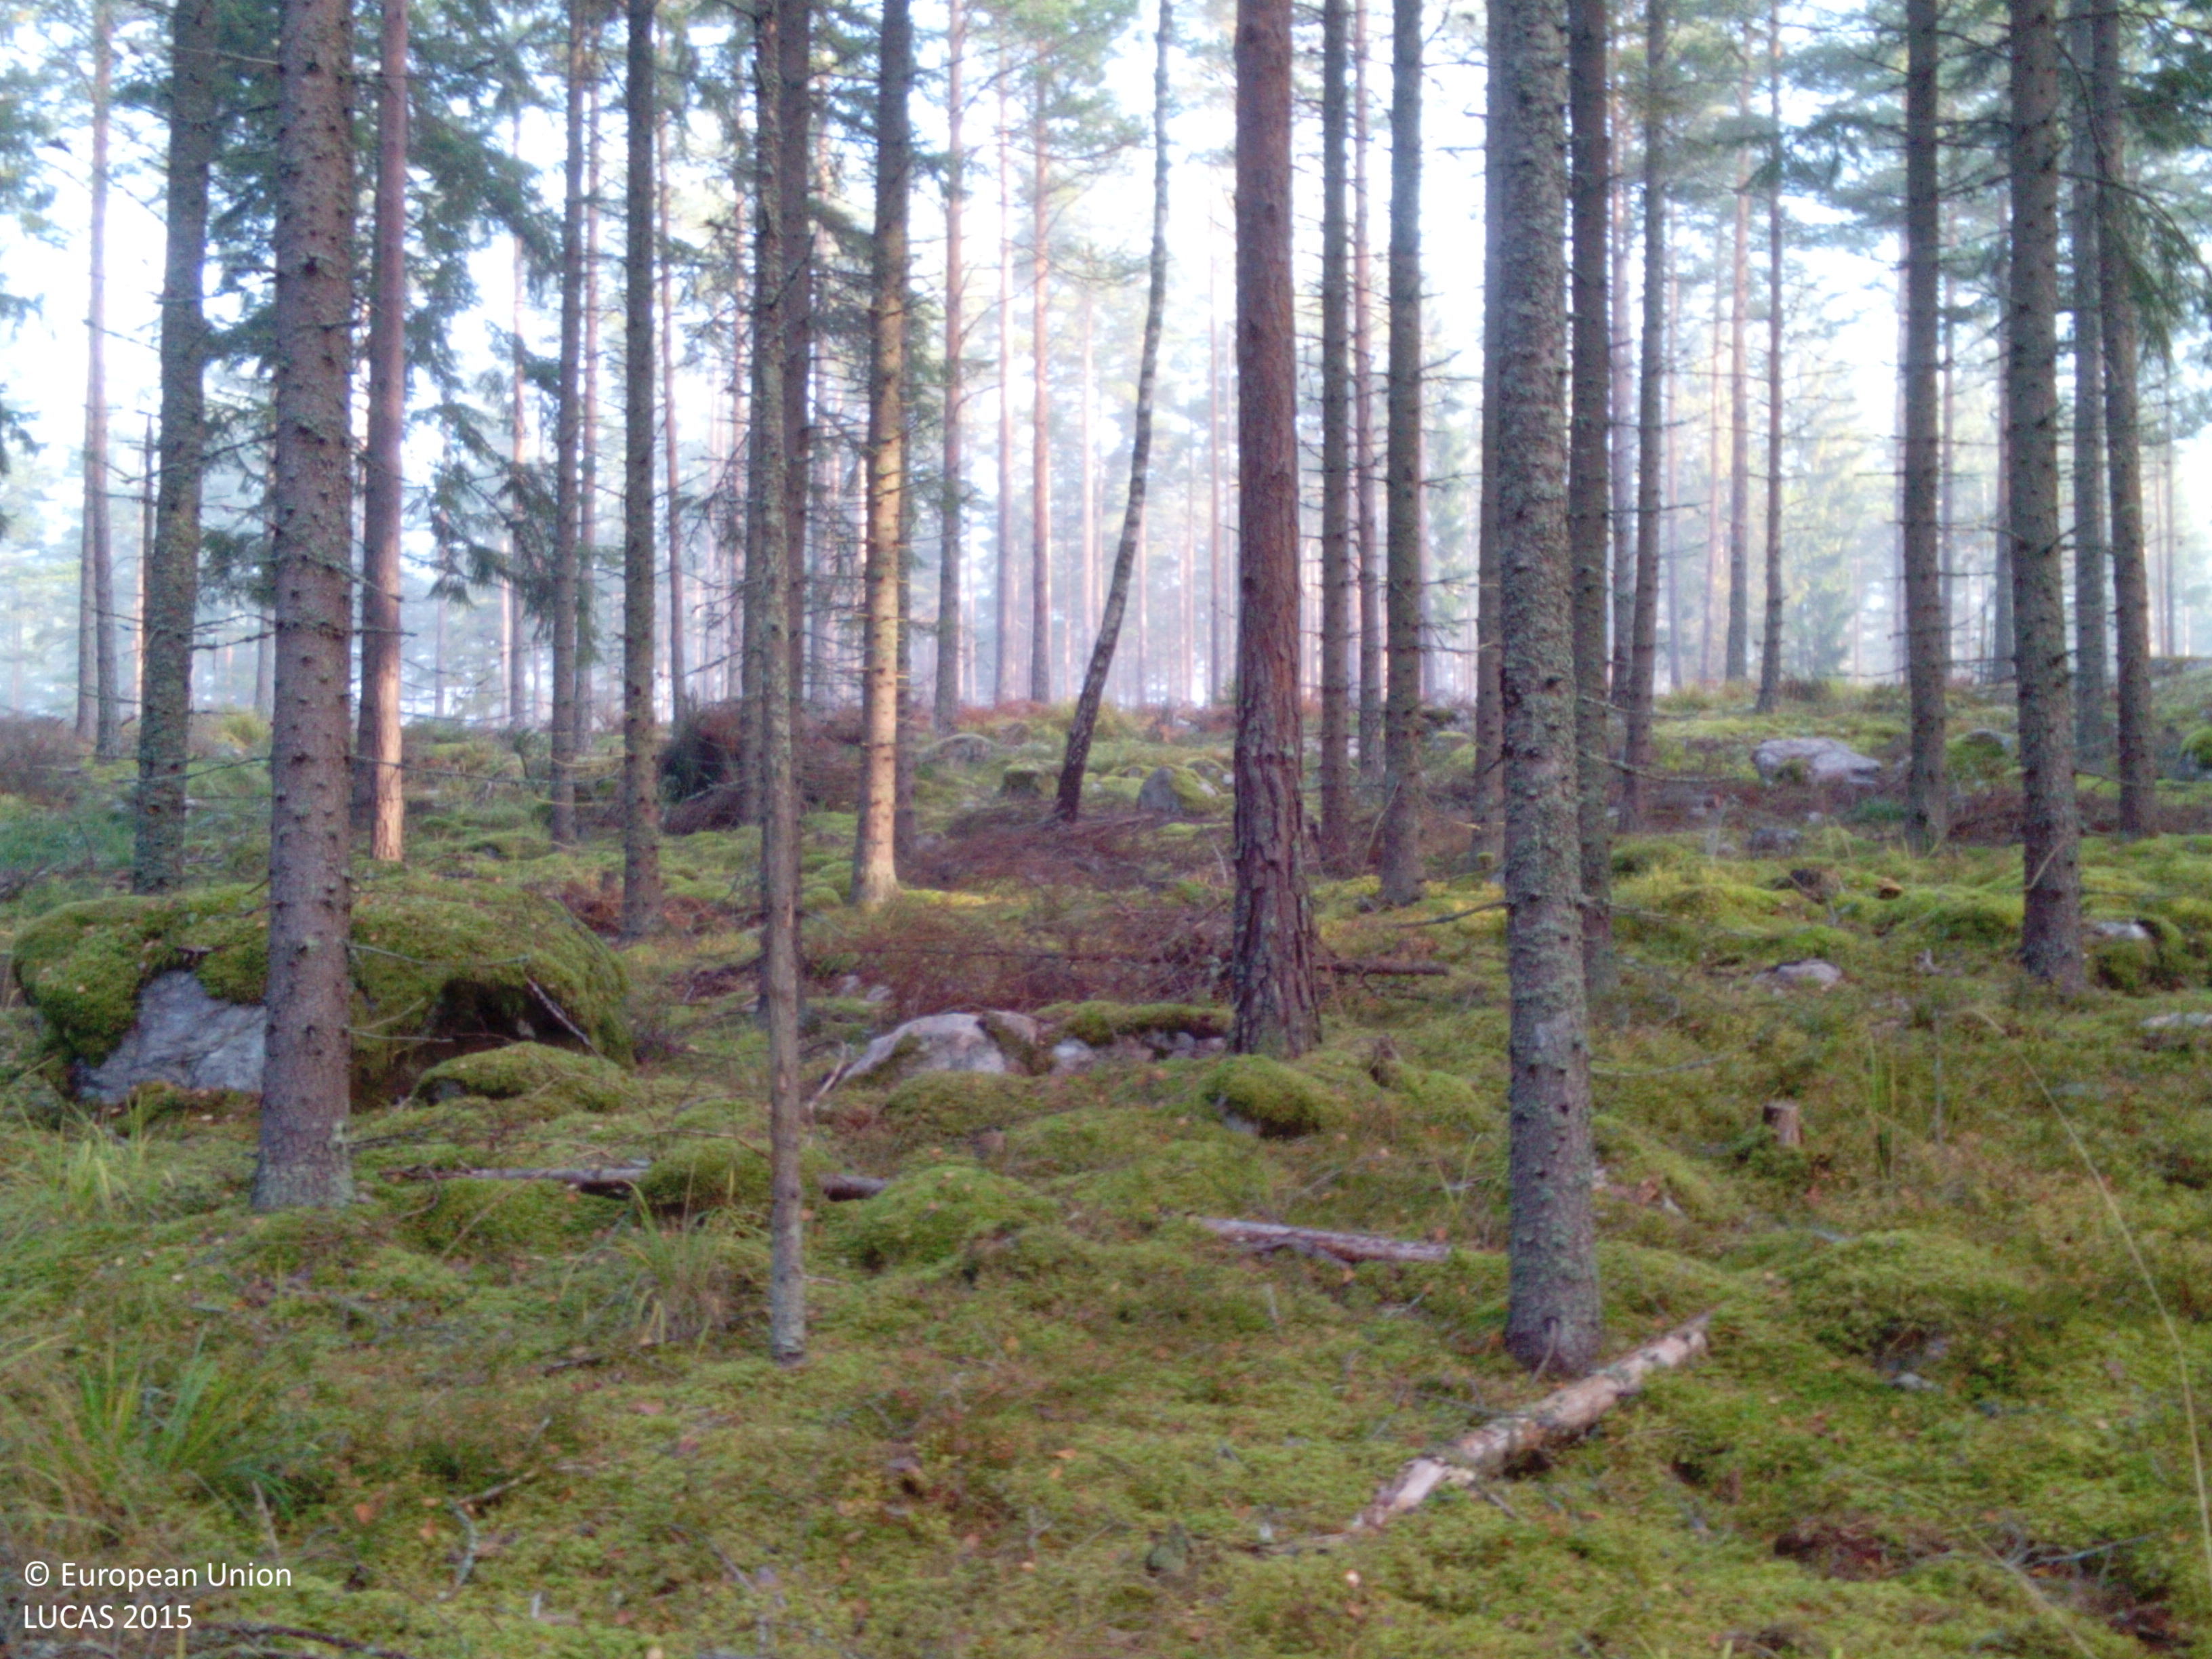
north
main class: Woodland
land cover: Other coniferous woodland
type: boreal forest
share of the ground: > 75 %
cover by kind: coniferous forest trees 85 %, lichens and mosses 10 %, herbaceous plants 5 %
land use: Forestry
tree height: > 5 m
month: October
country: SE
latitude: 58.8292
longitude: 16.3169
